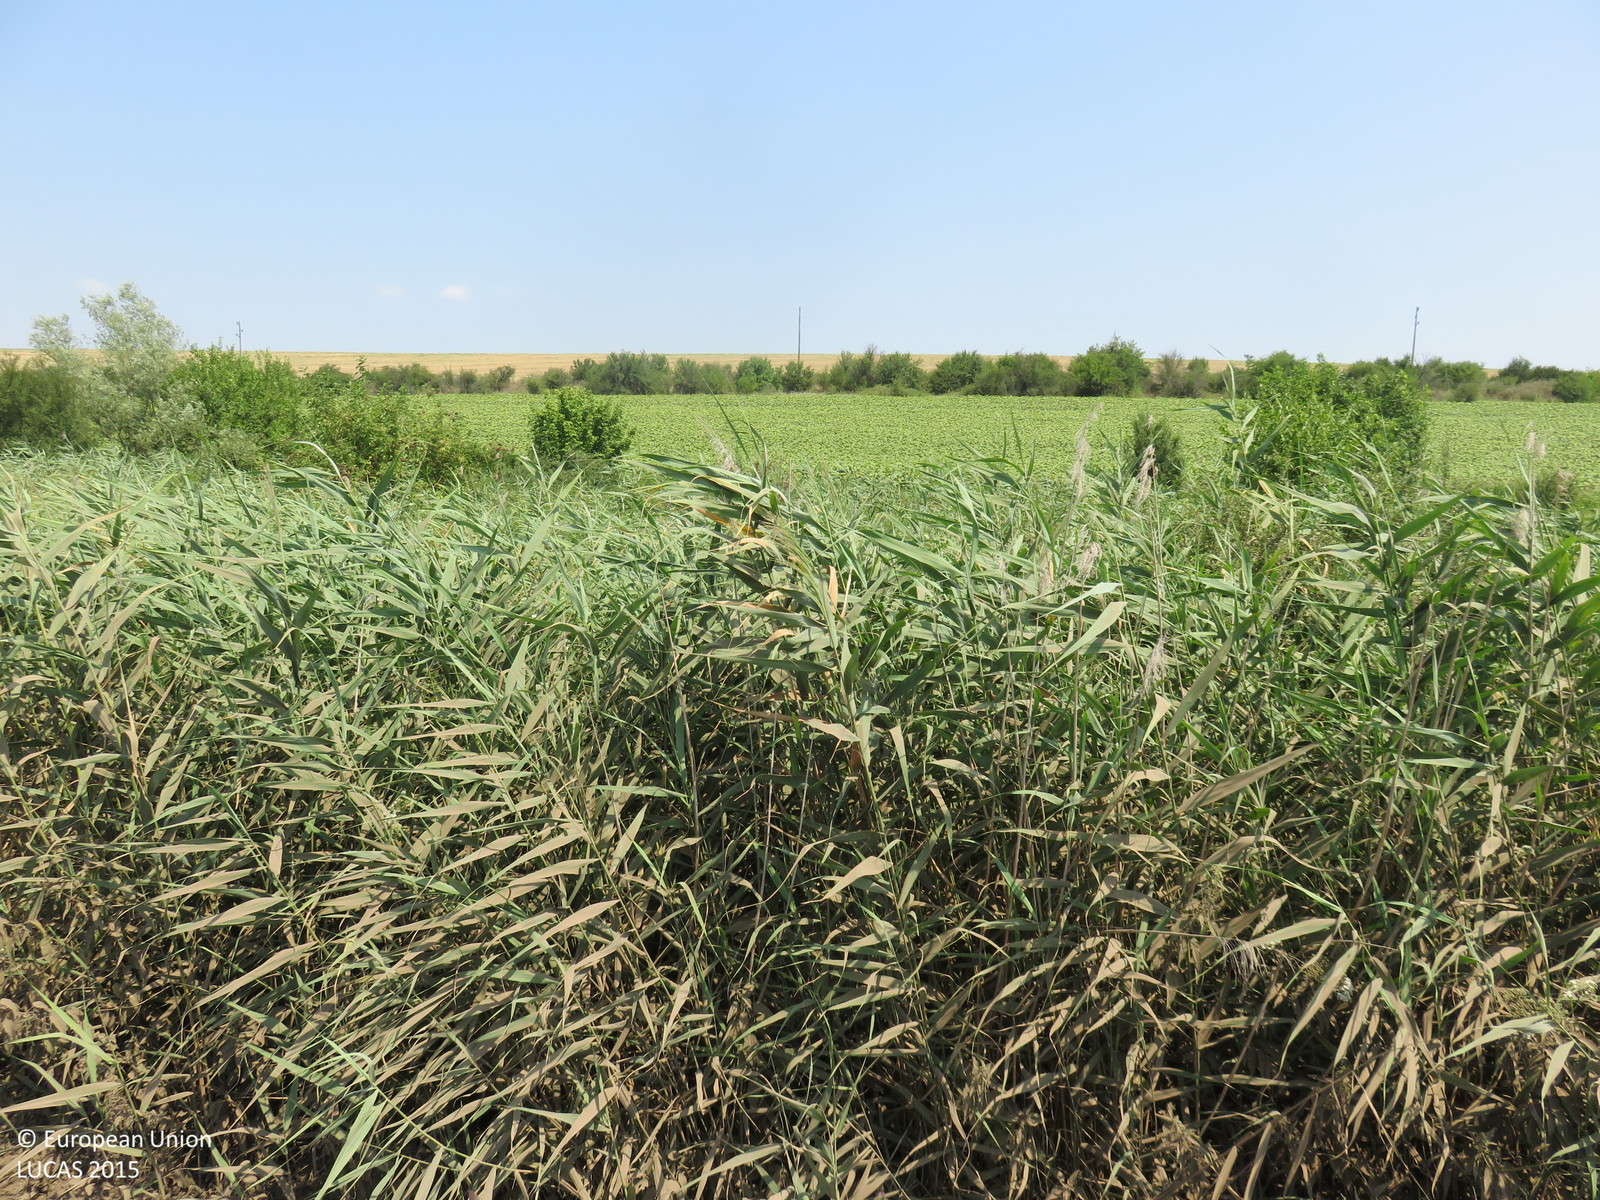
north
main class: Cropland
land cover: Sunflower
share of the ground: > 75 %
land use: Agriculture (excluding fallow land and kitchen gardens)
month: July
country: BG
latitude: 43.5441
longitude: 25.1366
